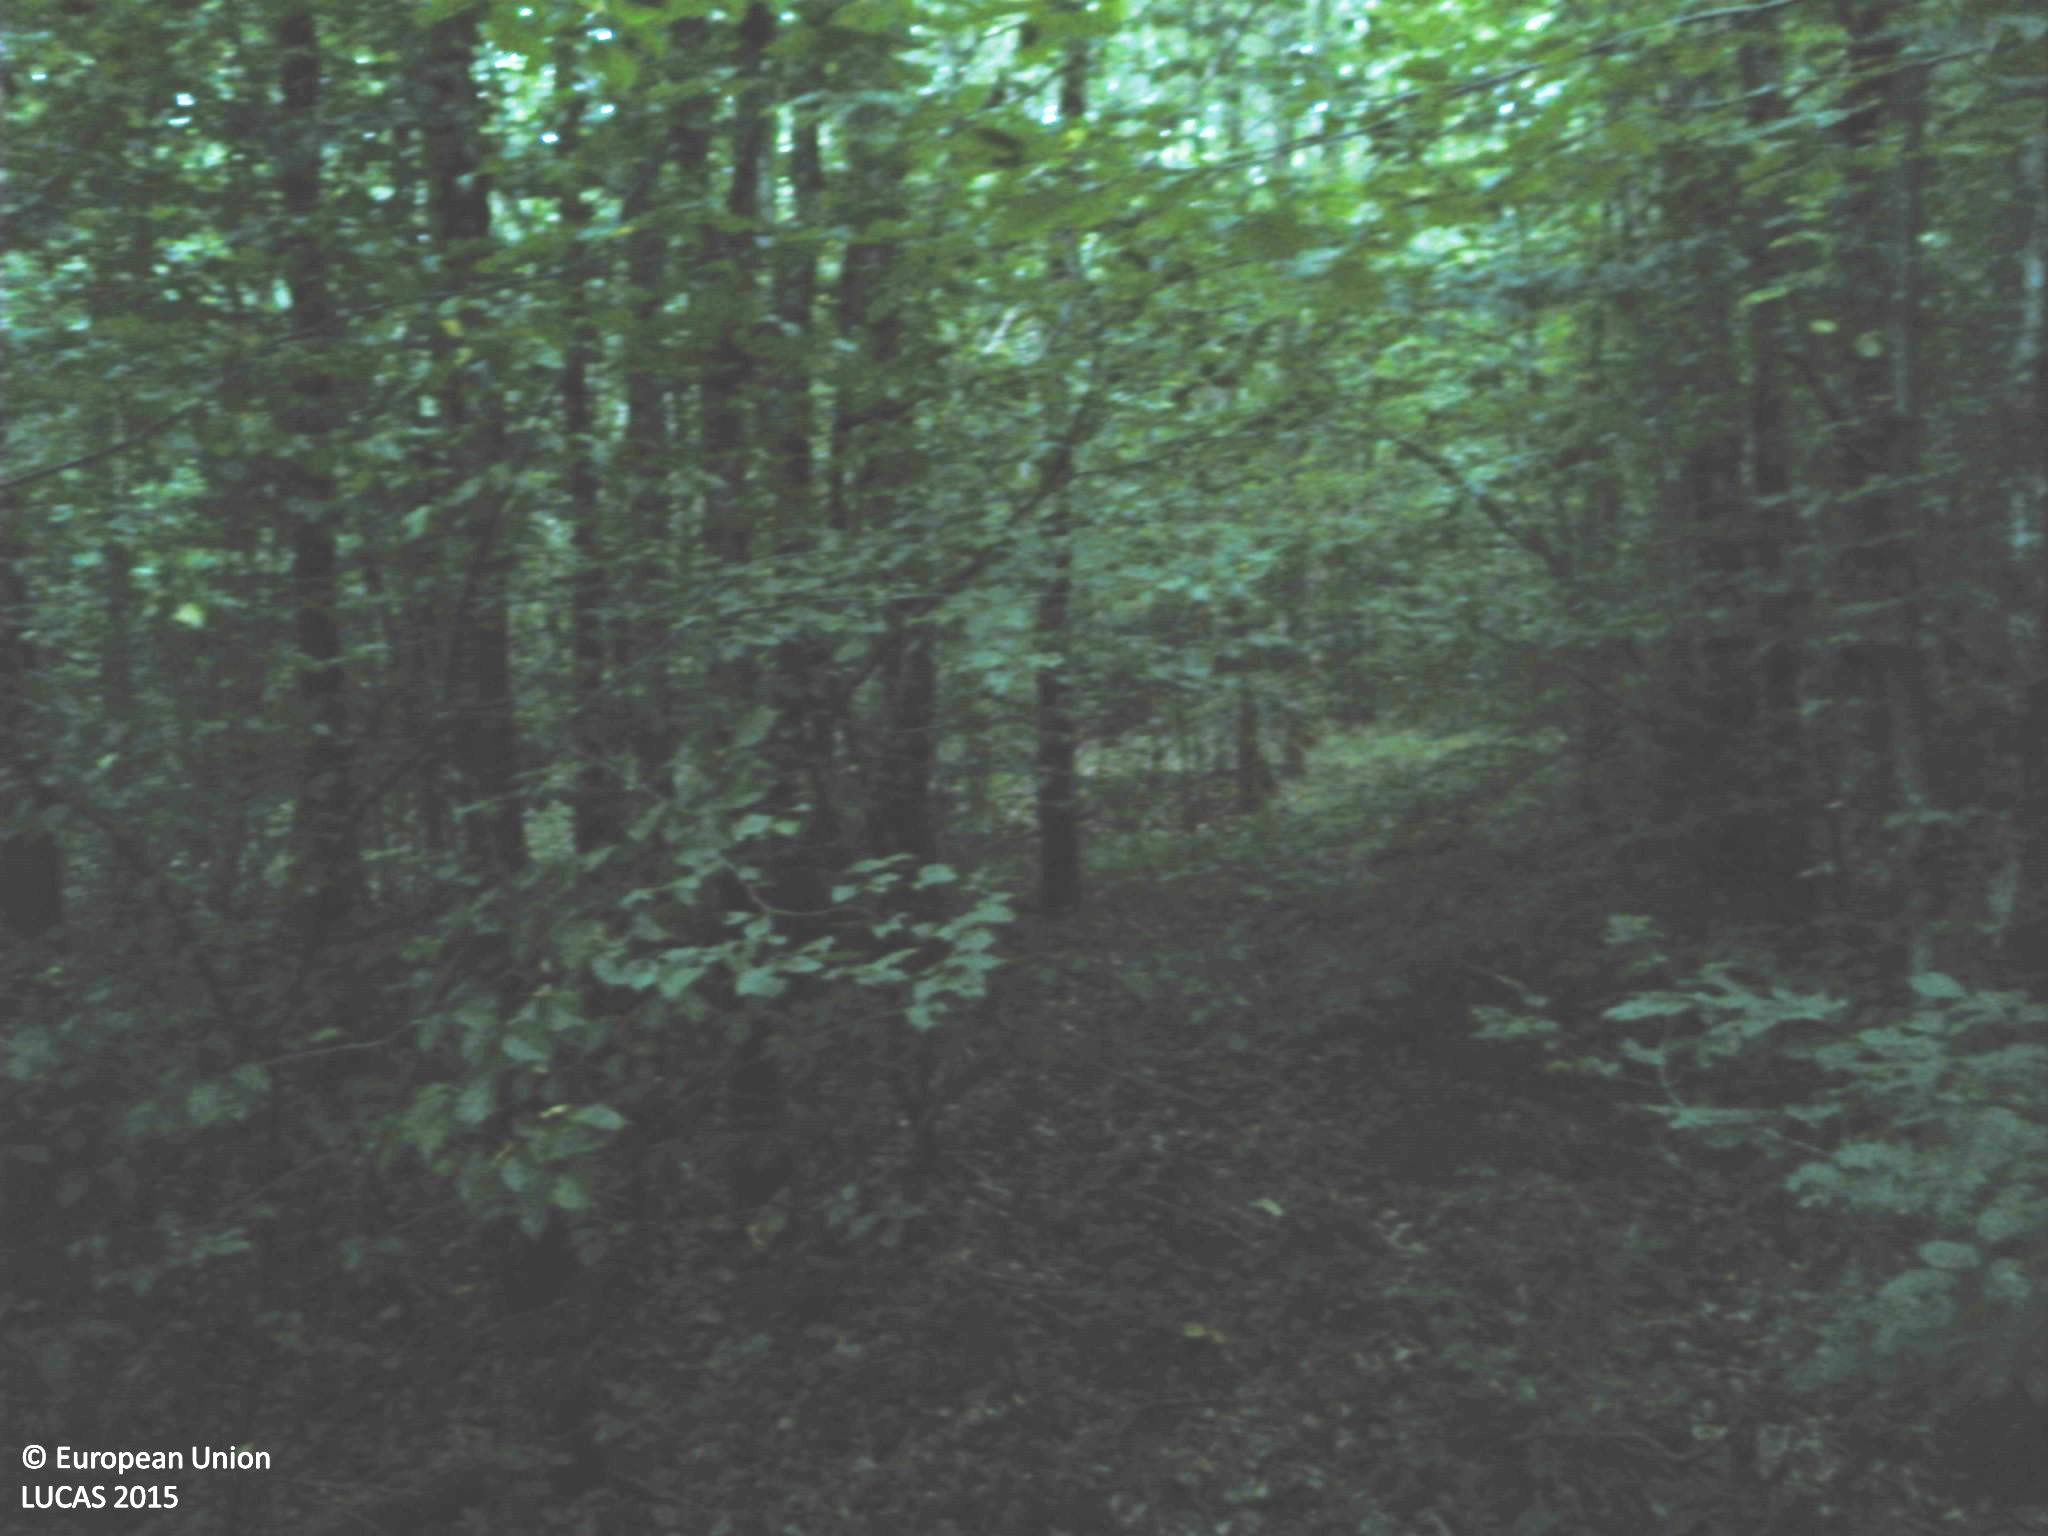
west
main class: Woodland
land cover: Broadleaved woodland
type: beech forest
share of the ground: > 75 %
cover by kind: broadleaved forest trees 90 %, unconsolidated bare surface 10 %
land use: Forestry
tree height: > 5 m
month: July
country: FR
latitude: 48.0643
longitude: 6.0956
